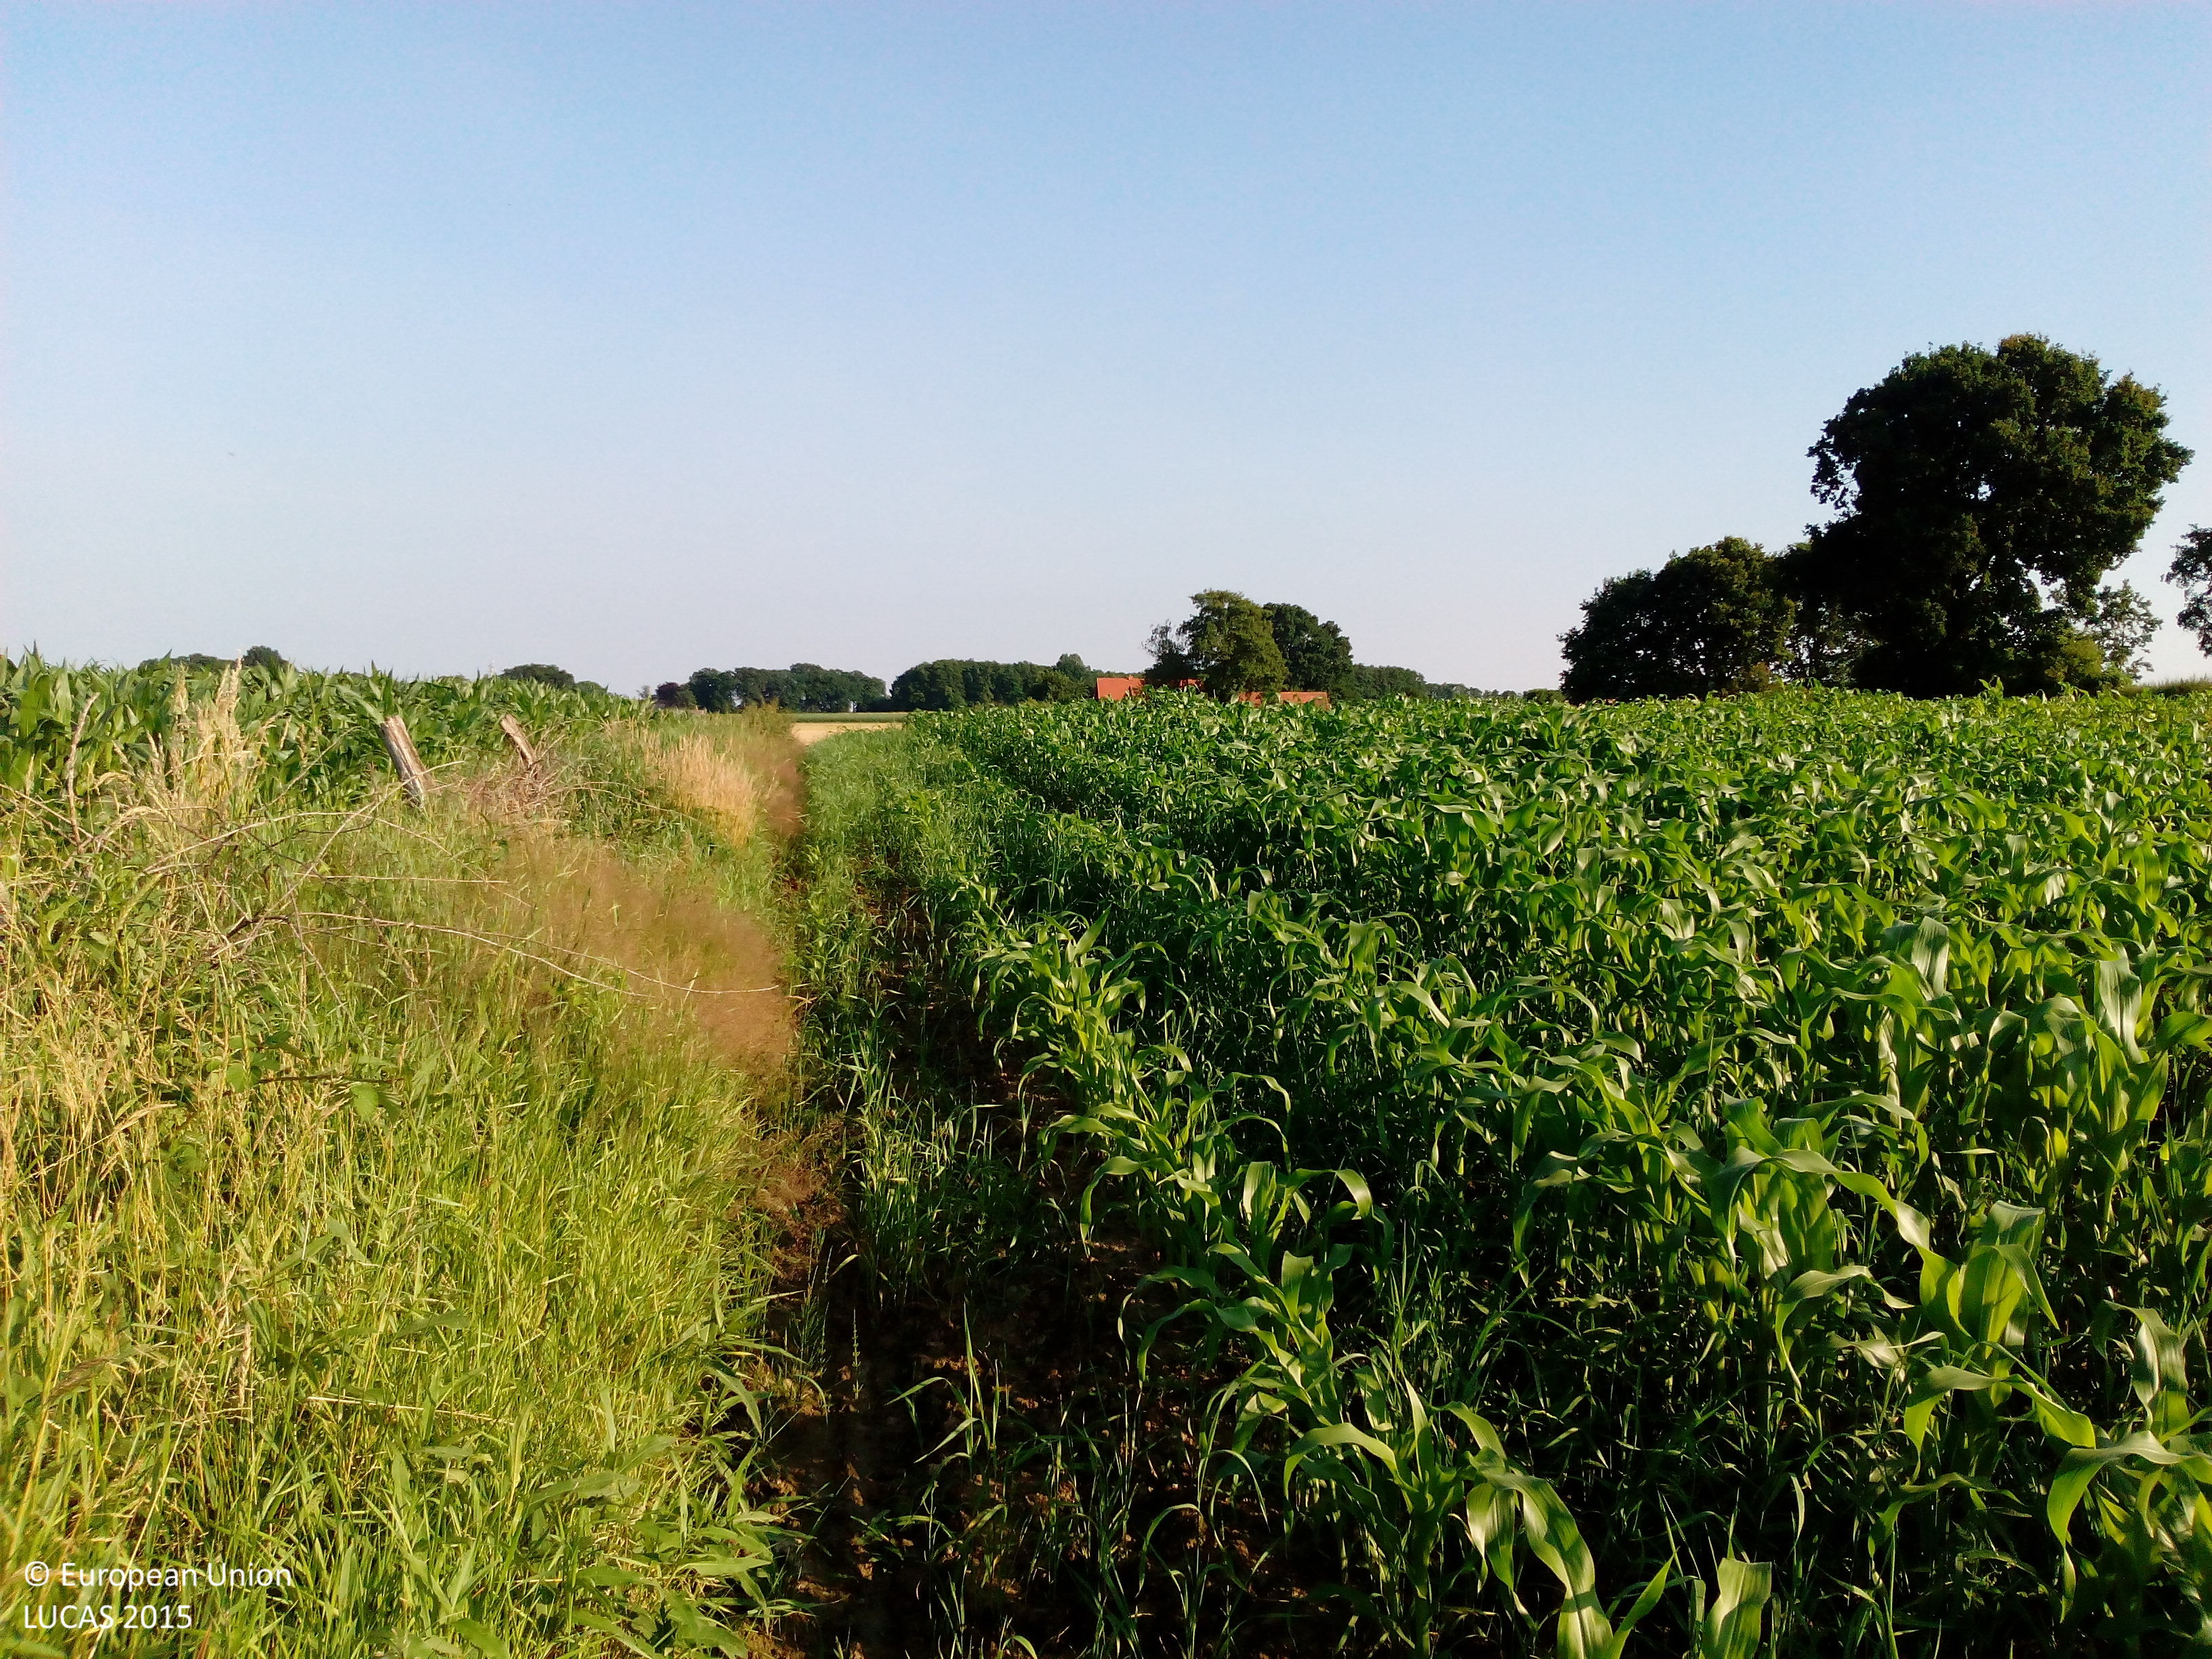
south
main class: Cropland
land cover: Maize
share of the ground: > 75 %
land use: Agriculture (excluding fallow land and kitchen gardens)
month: July
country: DE
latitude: 52.5216
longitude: 7.9519
